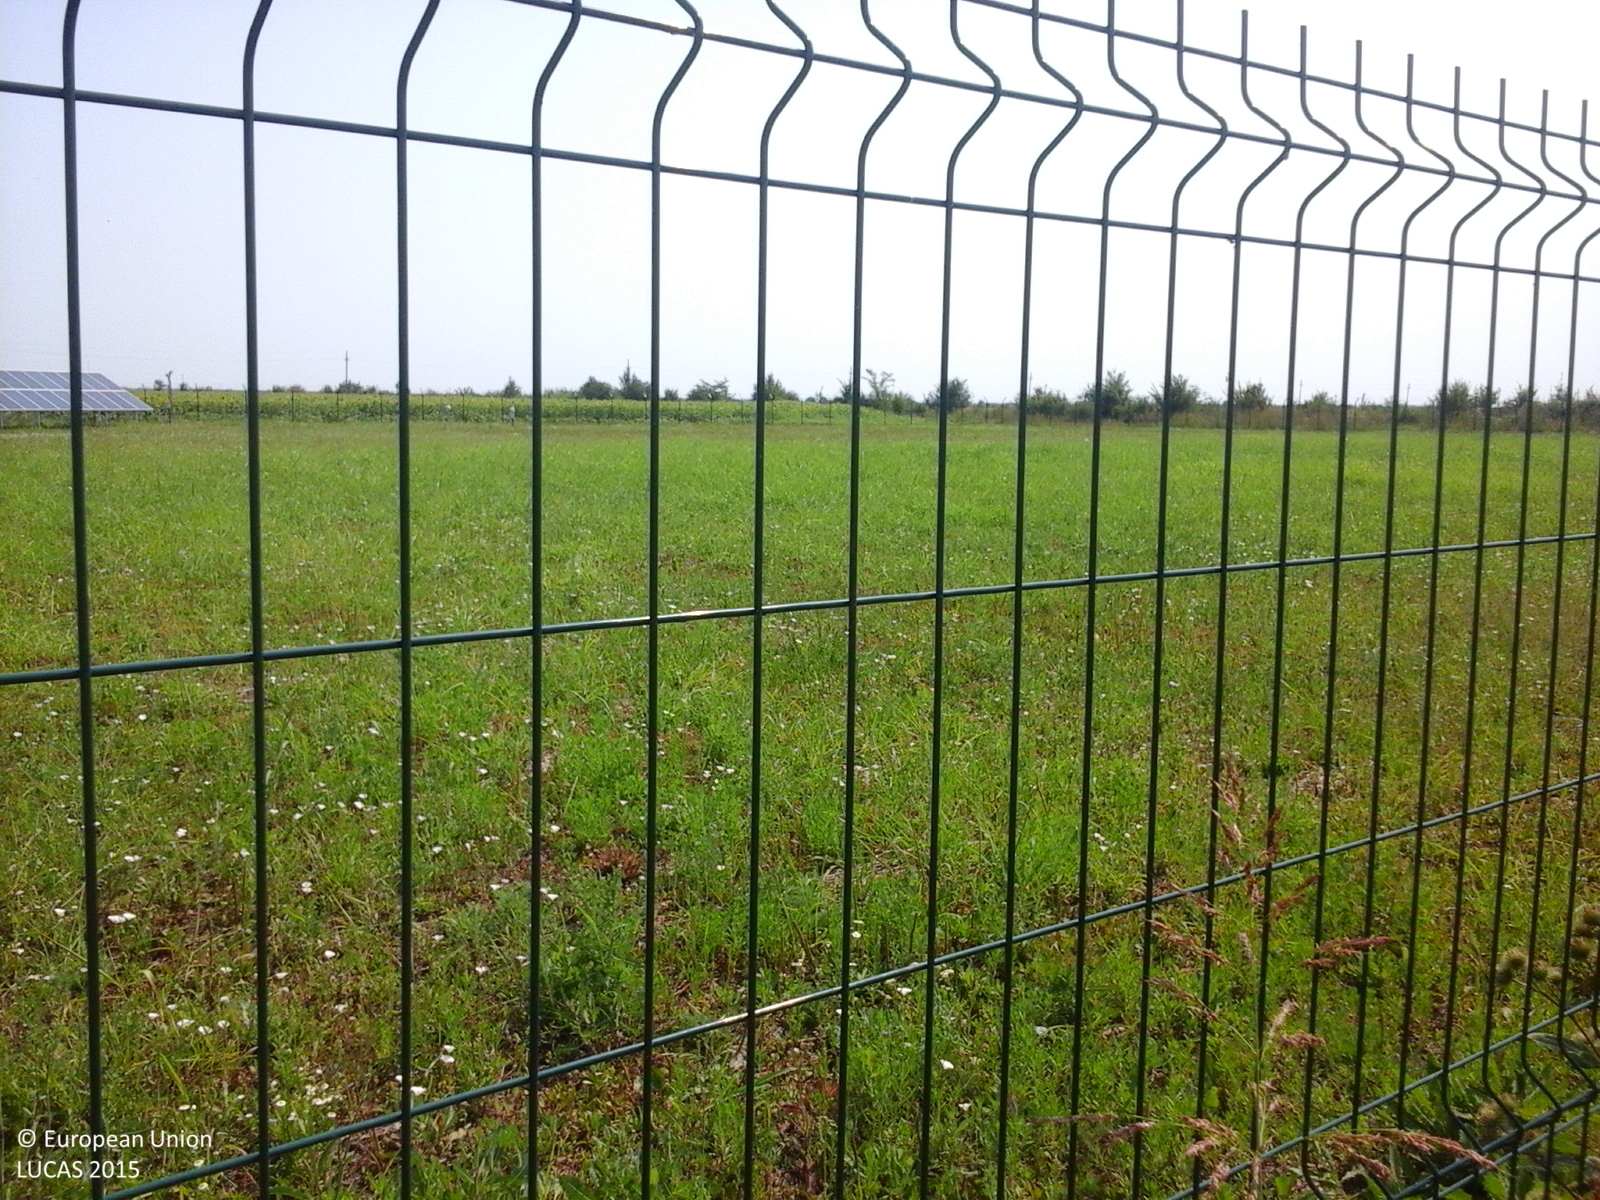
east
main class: Artificial land
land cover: Other artificial areas
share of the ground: > 75 %
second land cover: Grassland without tree/shrub cover
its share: > 75 %
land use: Energy production
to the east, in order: Artificial constructions in urban areas; Grassland without tree/shrub cover; Sunflower; Grass margins; Tracks; Grass margins; Abandoned hedges; Ditches and canals; Abandoned hedges; Common wheat
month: July
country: RO
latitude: 44.7287
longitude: 26.4944
